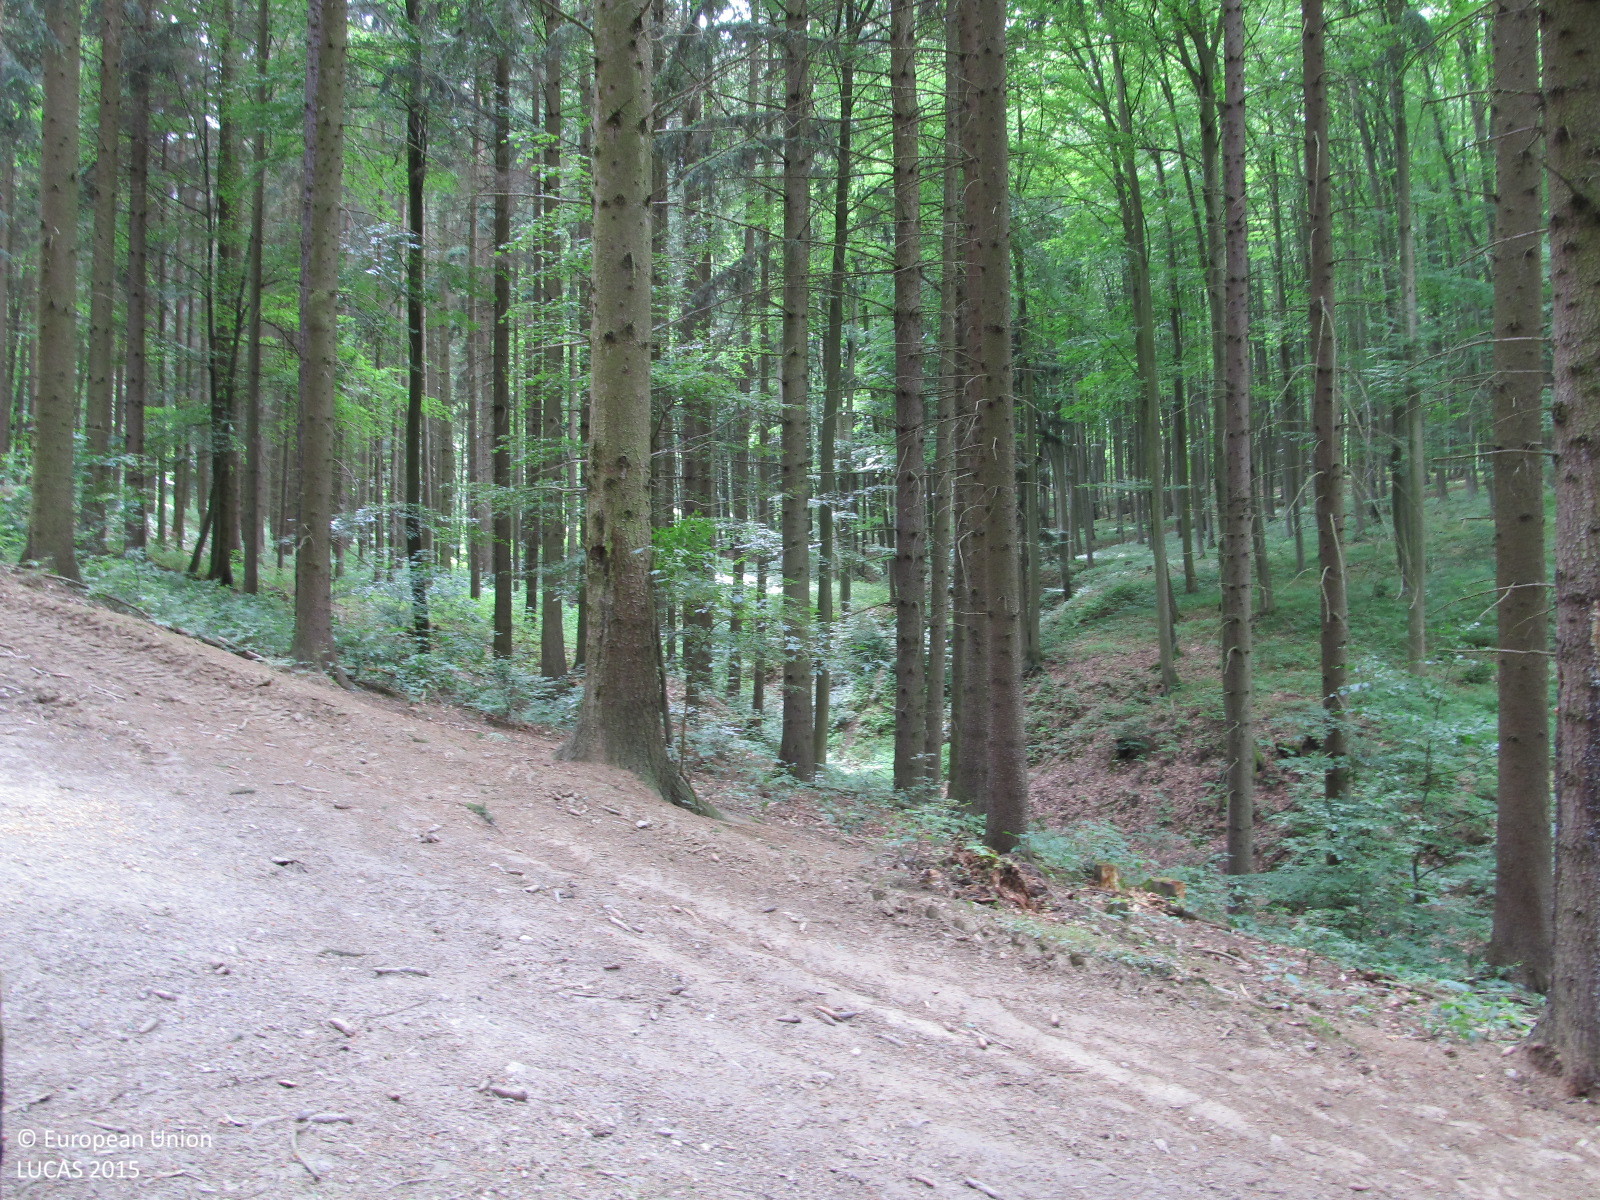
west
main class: Woodland
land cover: Spruce dominated mixed woodland
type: mountainous beech forest
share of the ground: > 75 %
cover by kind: coniferous forest trees 60 %, broadleaved forest trees 25 %, unconsolidated bare surface 10 %, shrubs 5 %
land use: Forestry
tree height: > 5 m
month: July
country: AT
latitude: 48.8260
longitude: 15.8477
